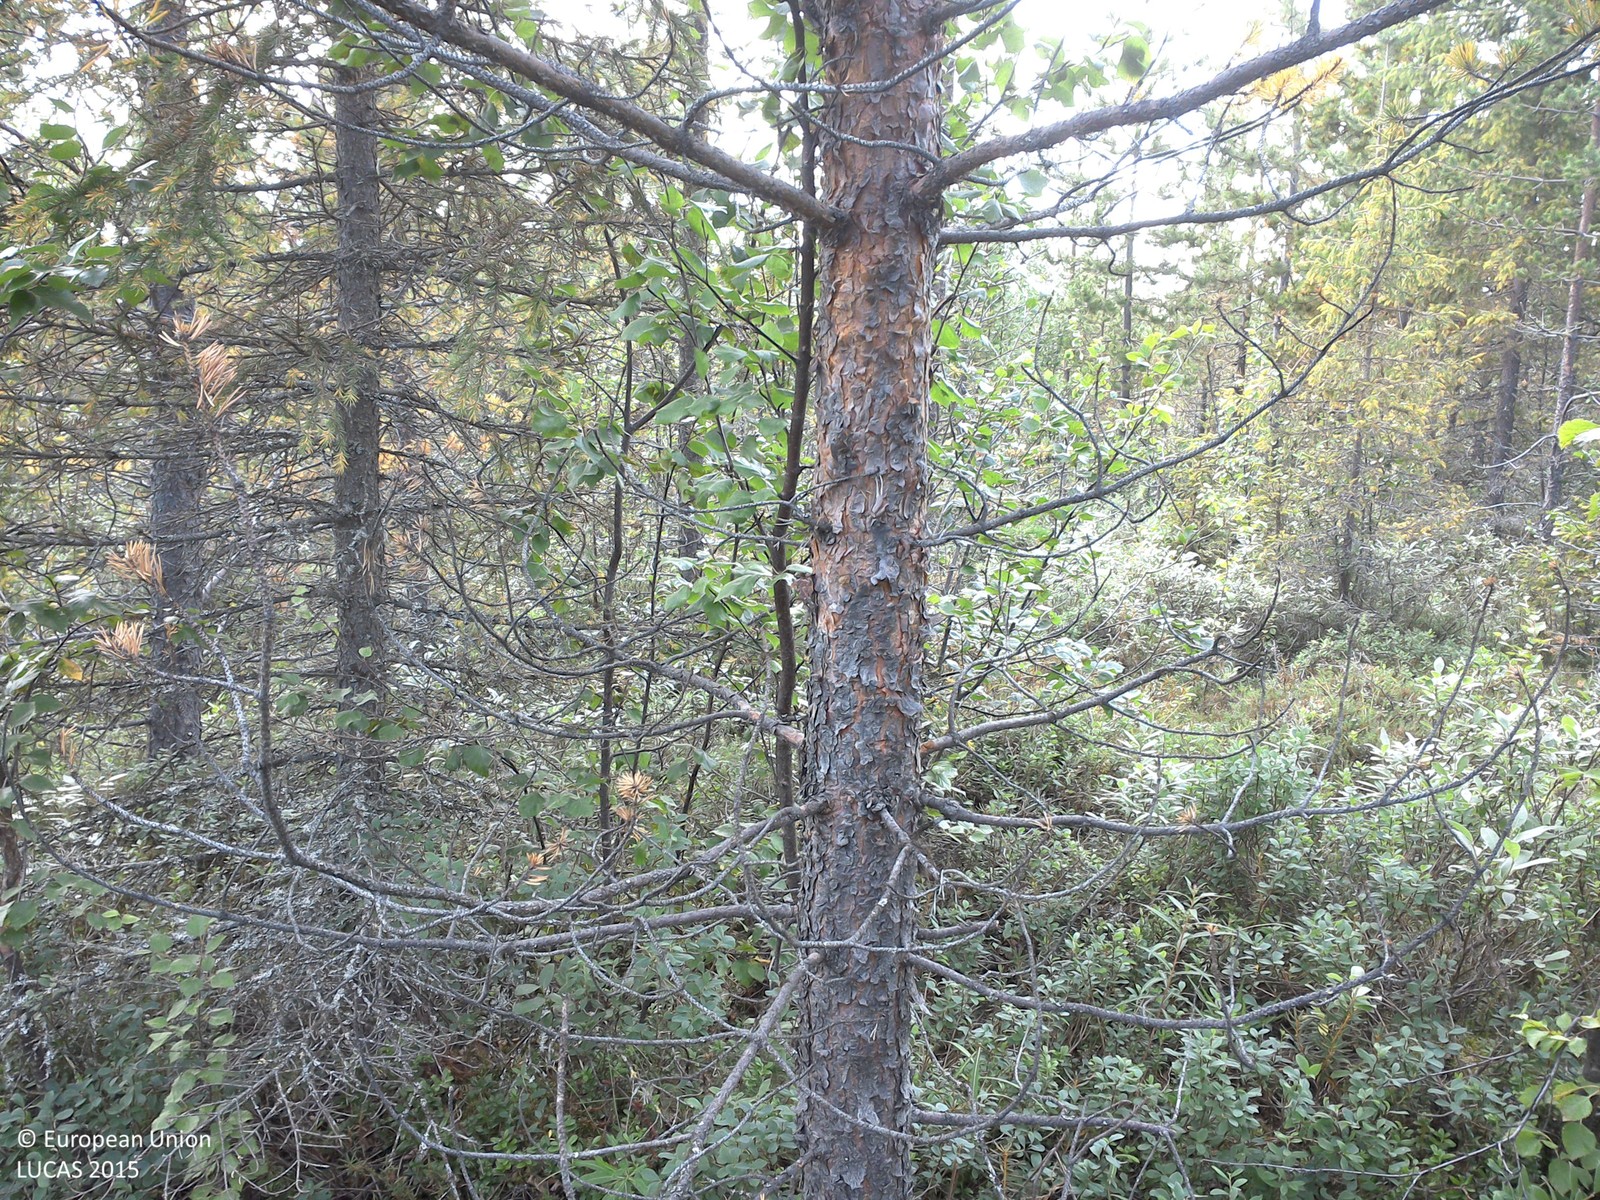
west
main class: Woodland
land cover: Pine dominated coniferous woodland
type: boreal forest
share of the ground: 25 - 50 %
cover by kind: shrubs 55 %, coniferous forest trees 30 %, lichens and mosses 10 %, broadleaved forest trees 5 %
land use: Forestry
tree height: < 5 m
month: August
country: SE
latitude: 67.8691
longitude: 20.5248
